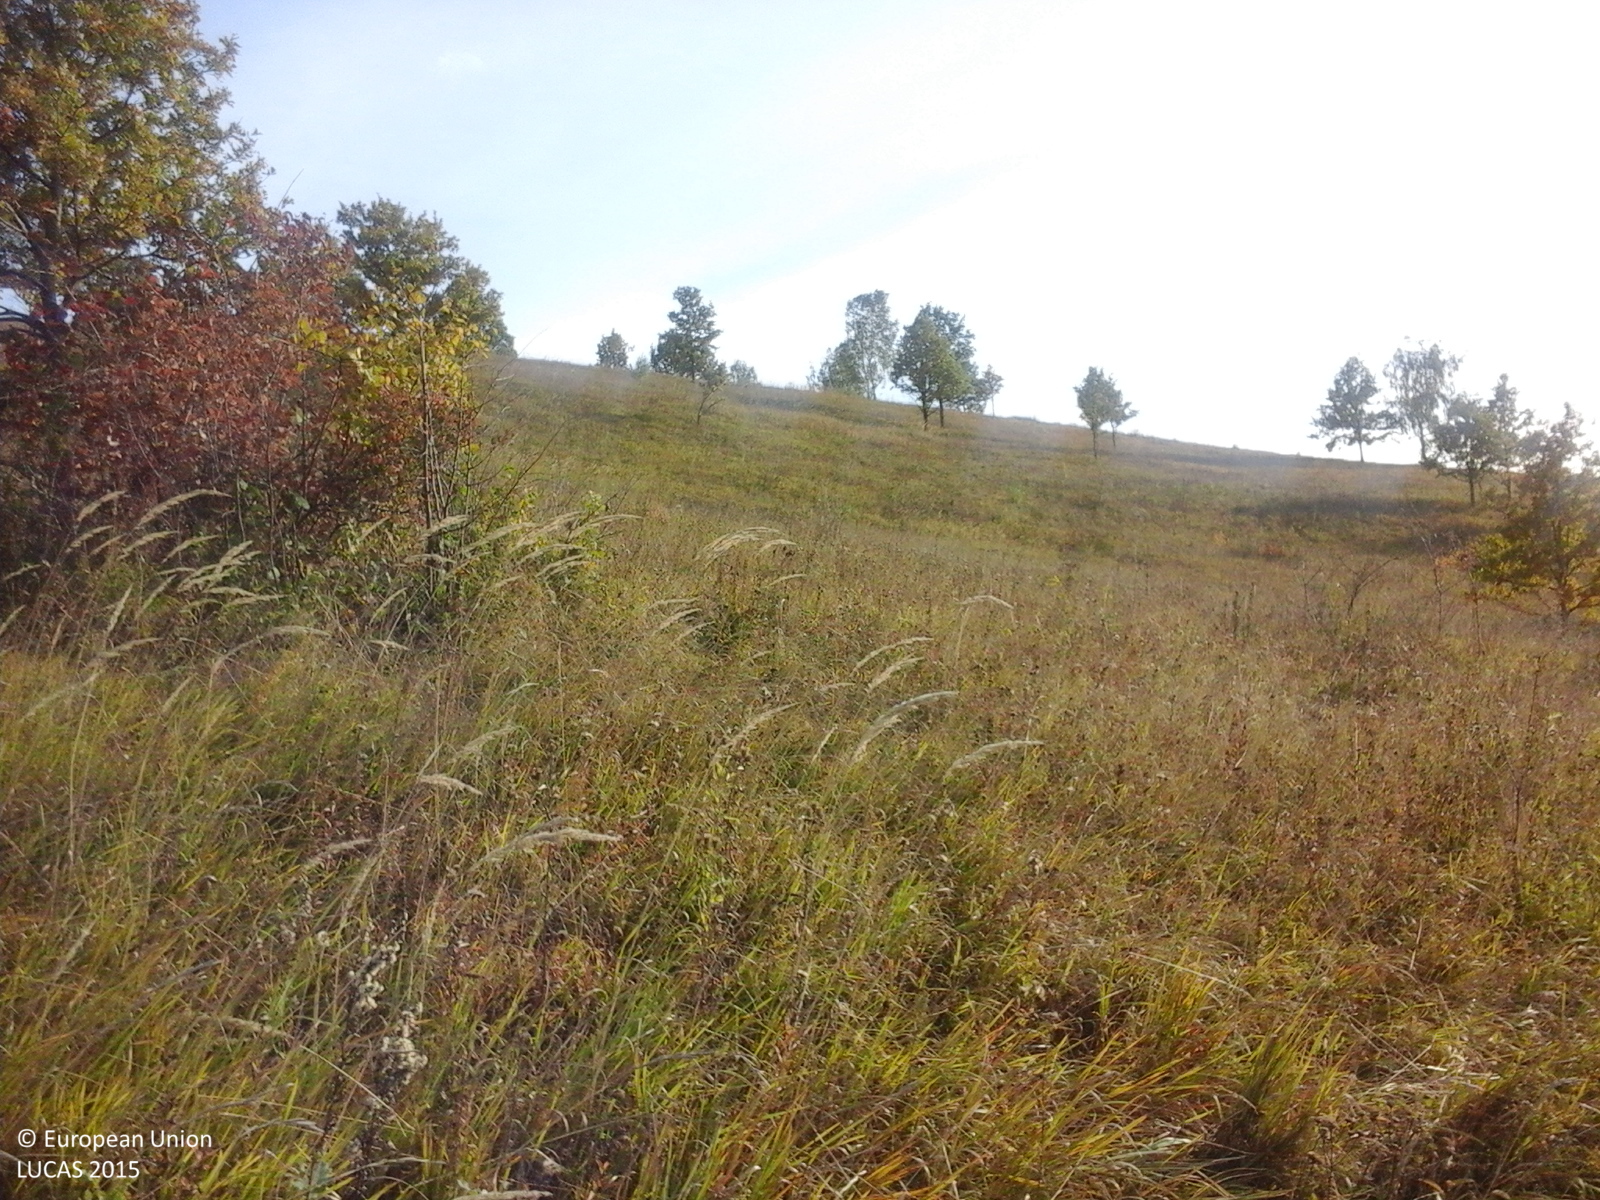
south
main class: Grassland
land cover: Grassland with sparse tree/shrub cover
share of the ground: > 75 %
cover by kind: herbaceous plants 95 %, broadleaved forest trees 5 %
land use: Agriculture (excluding fallow land and kitchen gardens)
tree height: > 5 m
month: October
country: RO
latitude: 46.0769
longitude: 25.8502
